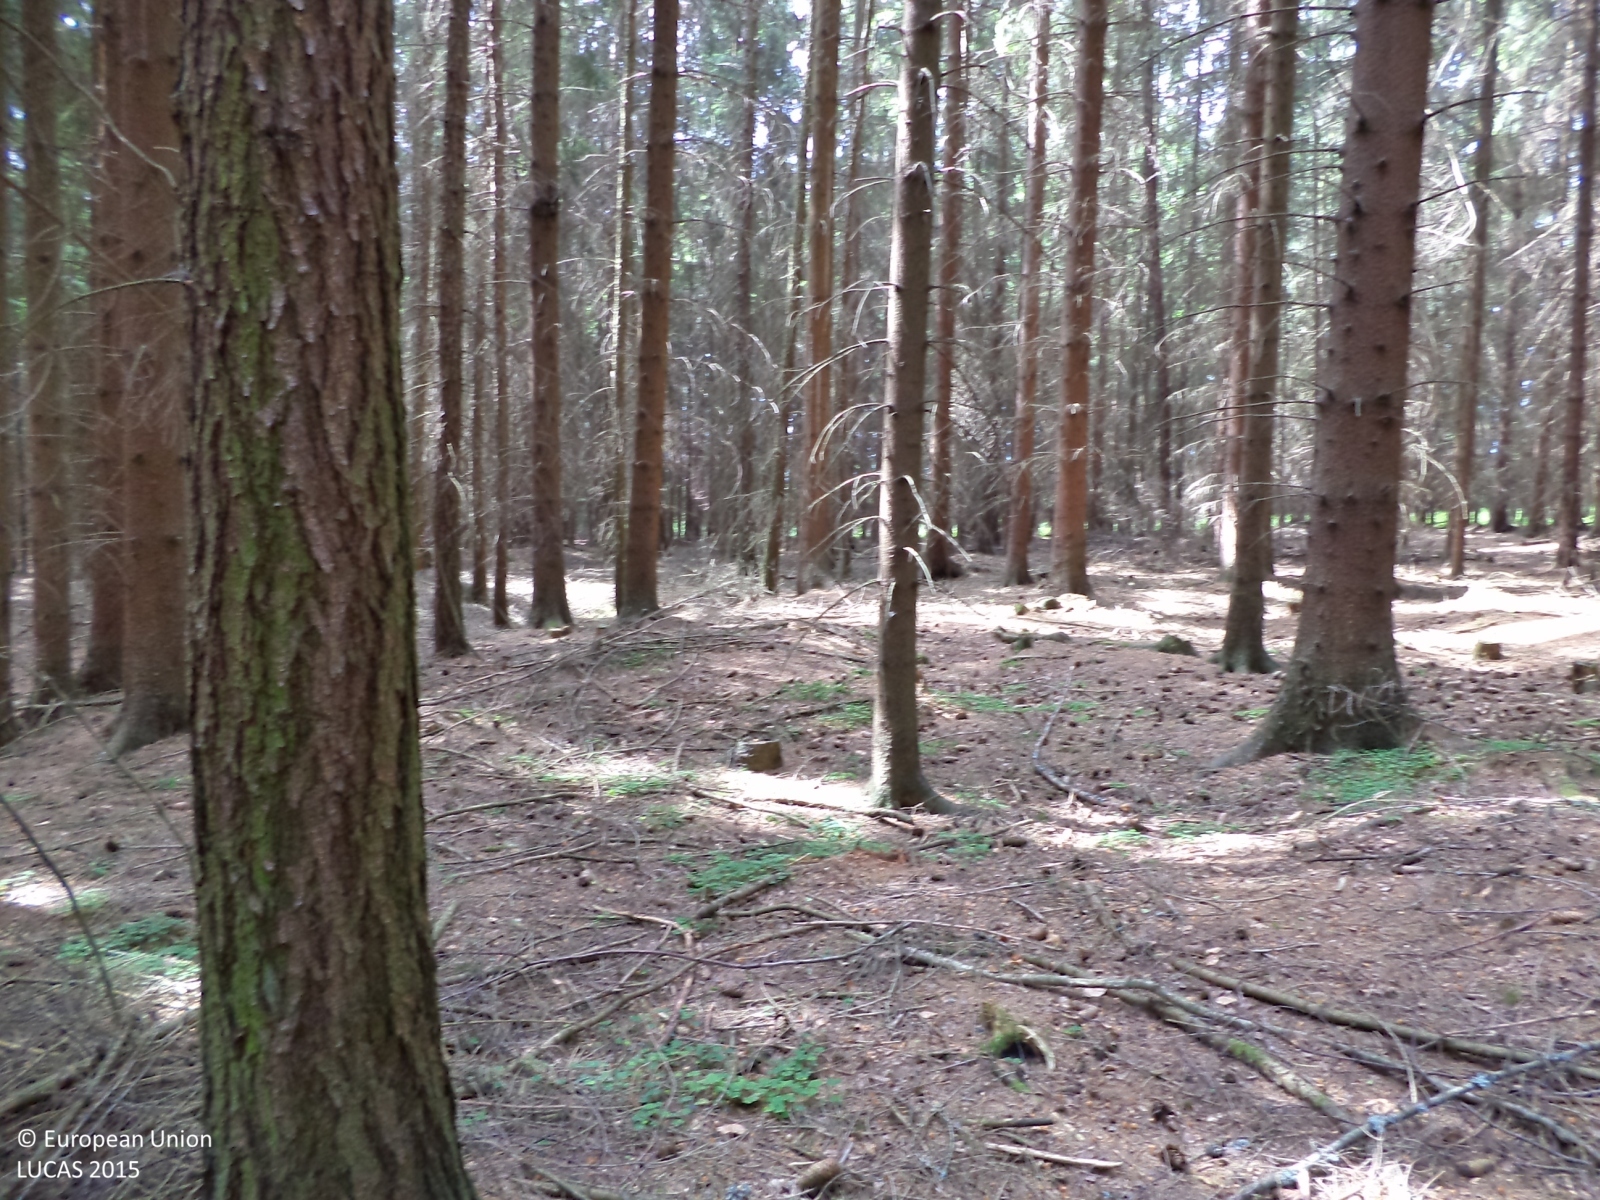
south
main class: Woodland
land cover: Spruce dominated coniferous woodland
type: hemiboreal forest and nemoral coniferous forest and mixed broadleaved-coniferous forest
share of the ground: > 75 %
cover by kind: coniferous forest trees 90 %, shrubs 5 %, lichens and mosses 5 %
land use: Forestry
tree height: > 5 m
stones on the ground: < 10 %
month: June
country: CZ
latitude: 49.5189
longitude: 14.9337
